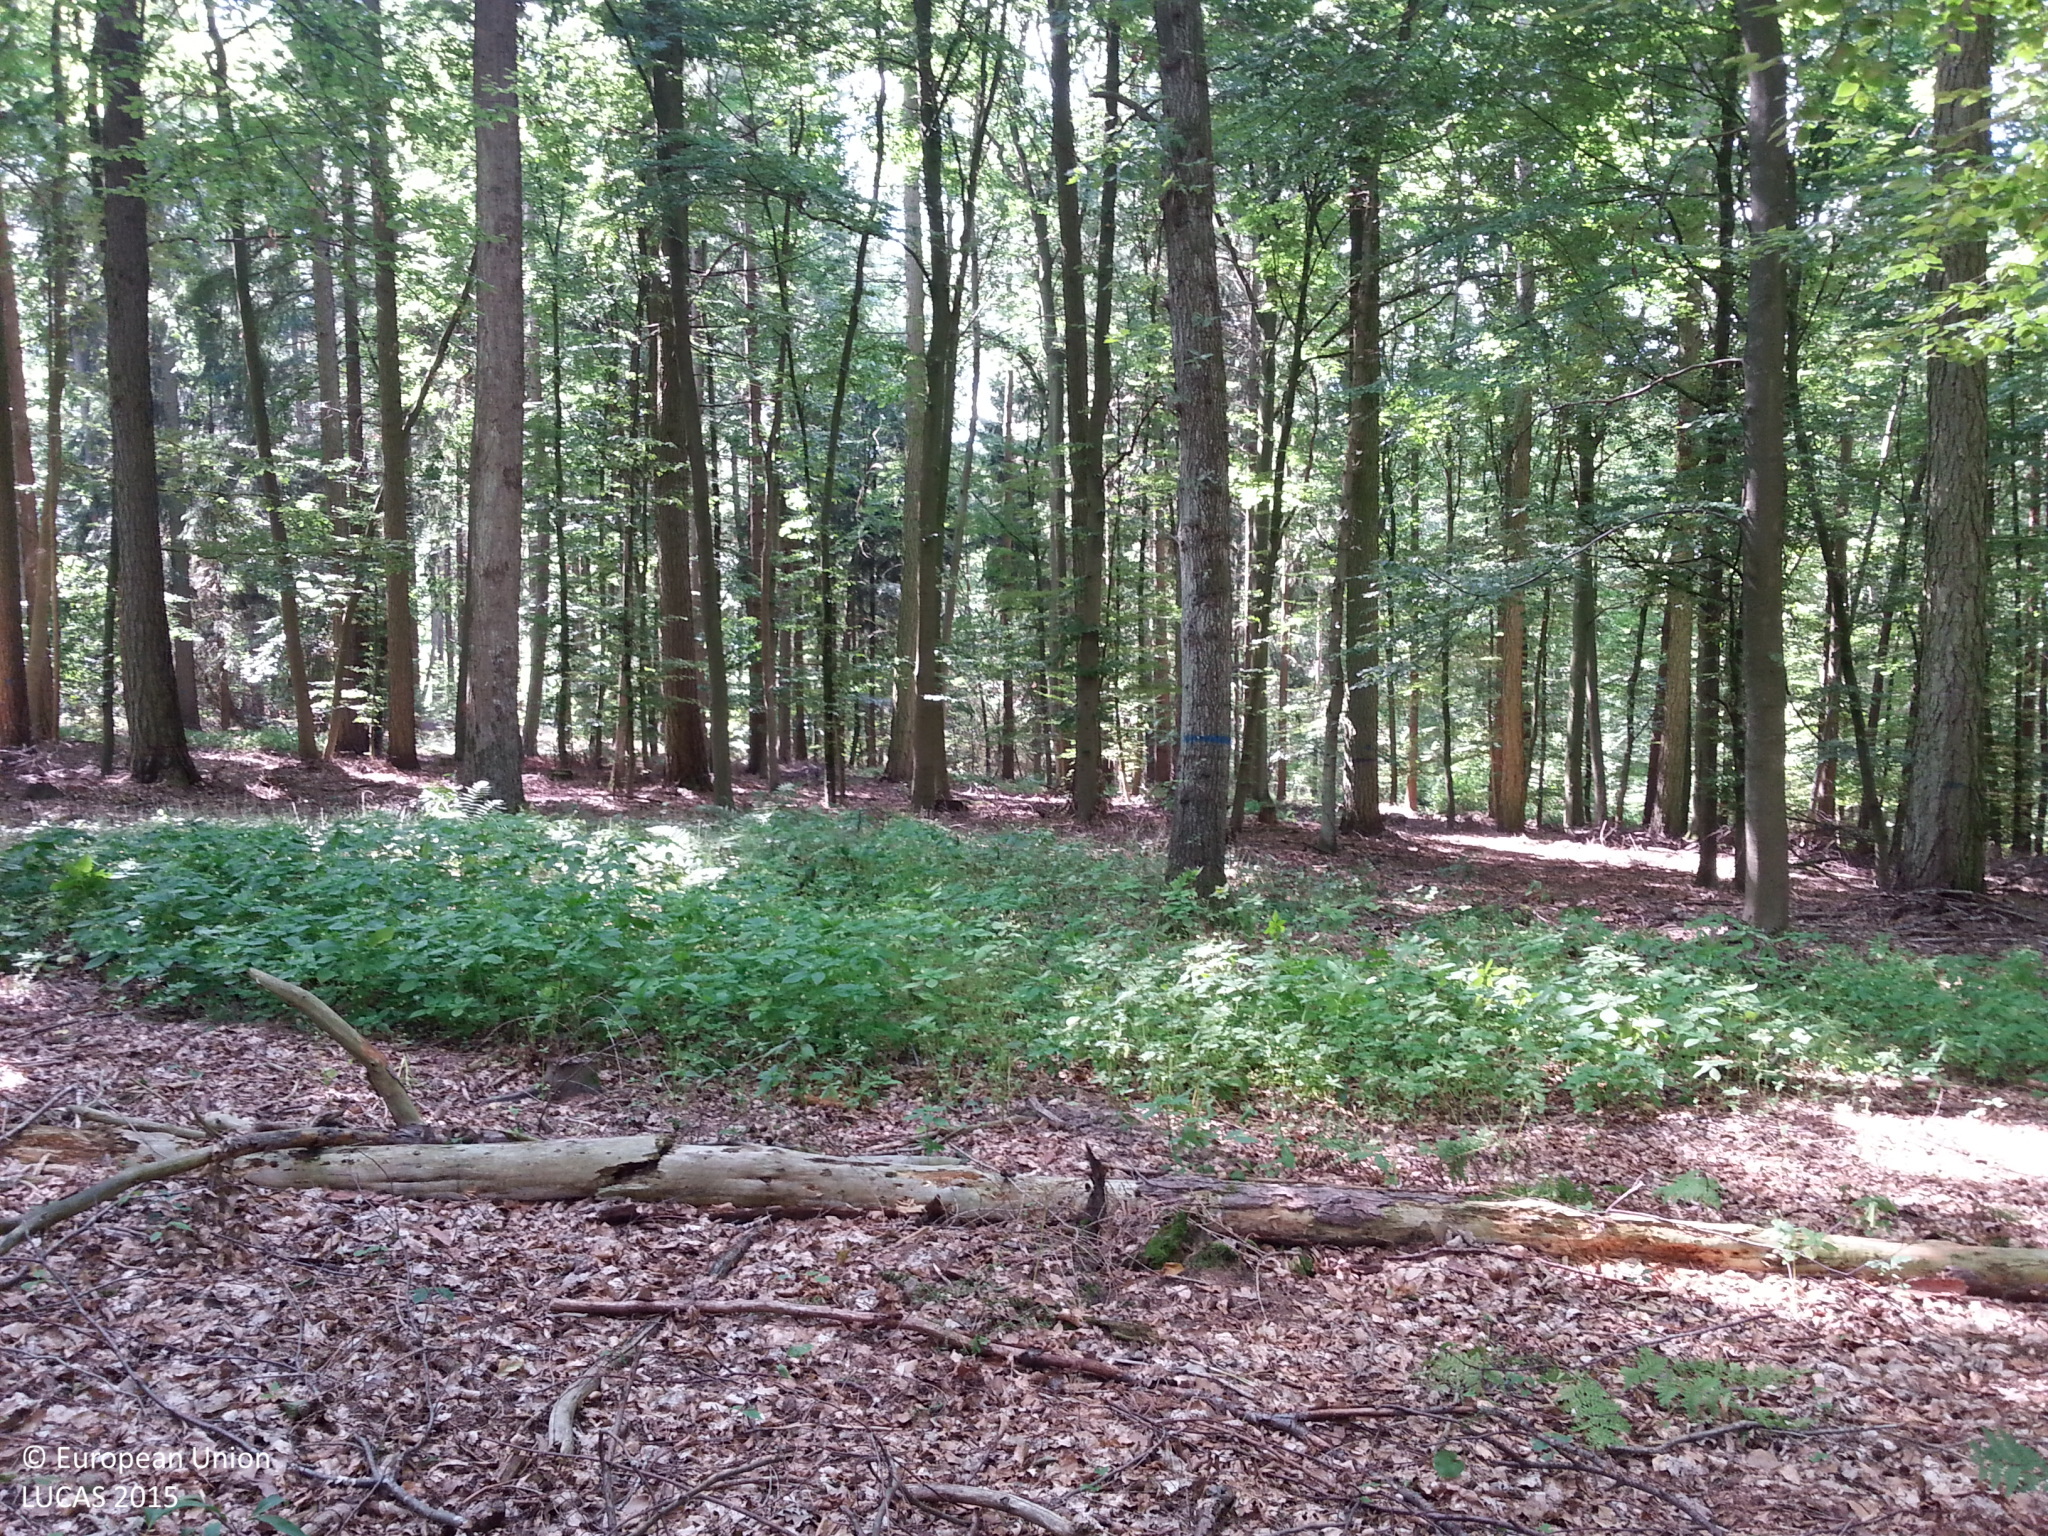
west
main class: Woodland
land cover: Other mixed woodland
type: hemiboreal forest and nemoral coniferous forest and mixed broadleaved-coniferous forest
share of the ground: > 75 %
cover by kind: broadleaved forest trees 50 %, coniferous forest trees 40 %, unconsolidated bare surface 10 %
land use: Forestry
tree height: > 5 m
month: August
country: DE
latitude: 49.4649
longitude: 9.9586
